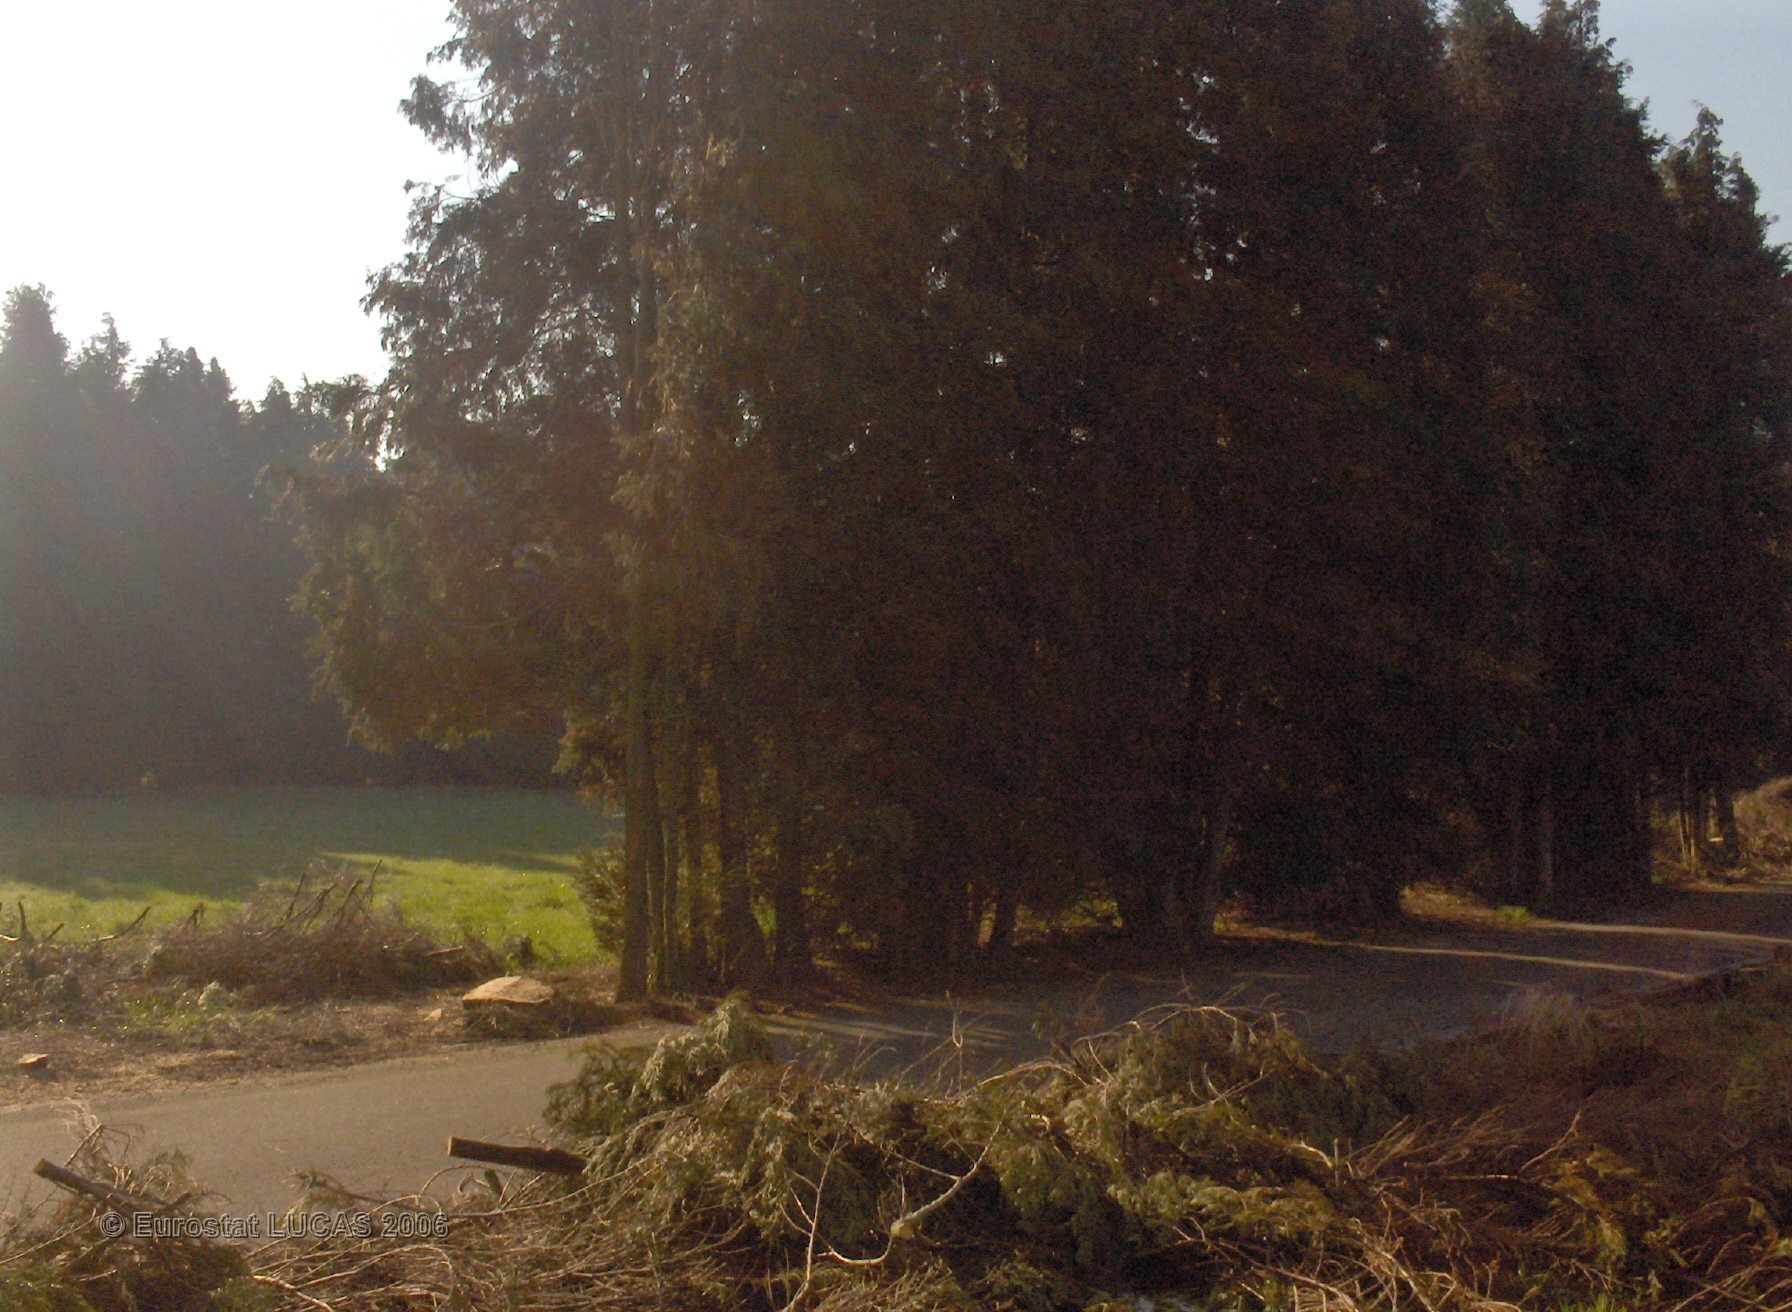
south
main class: Grassland
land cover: Grassland without tree/shrub cover
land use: Community services
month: April
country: BE
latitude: 50.4861
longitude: 4.5415
